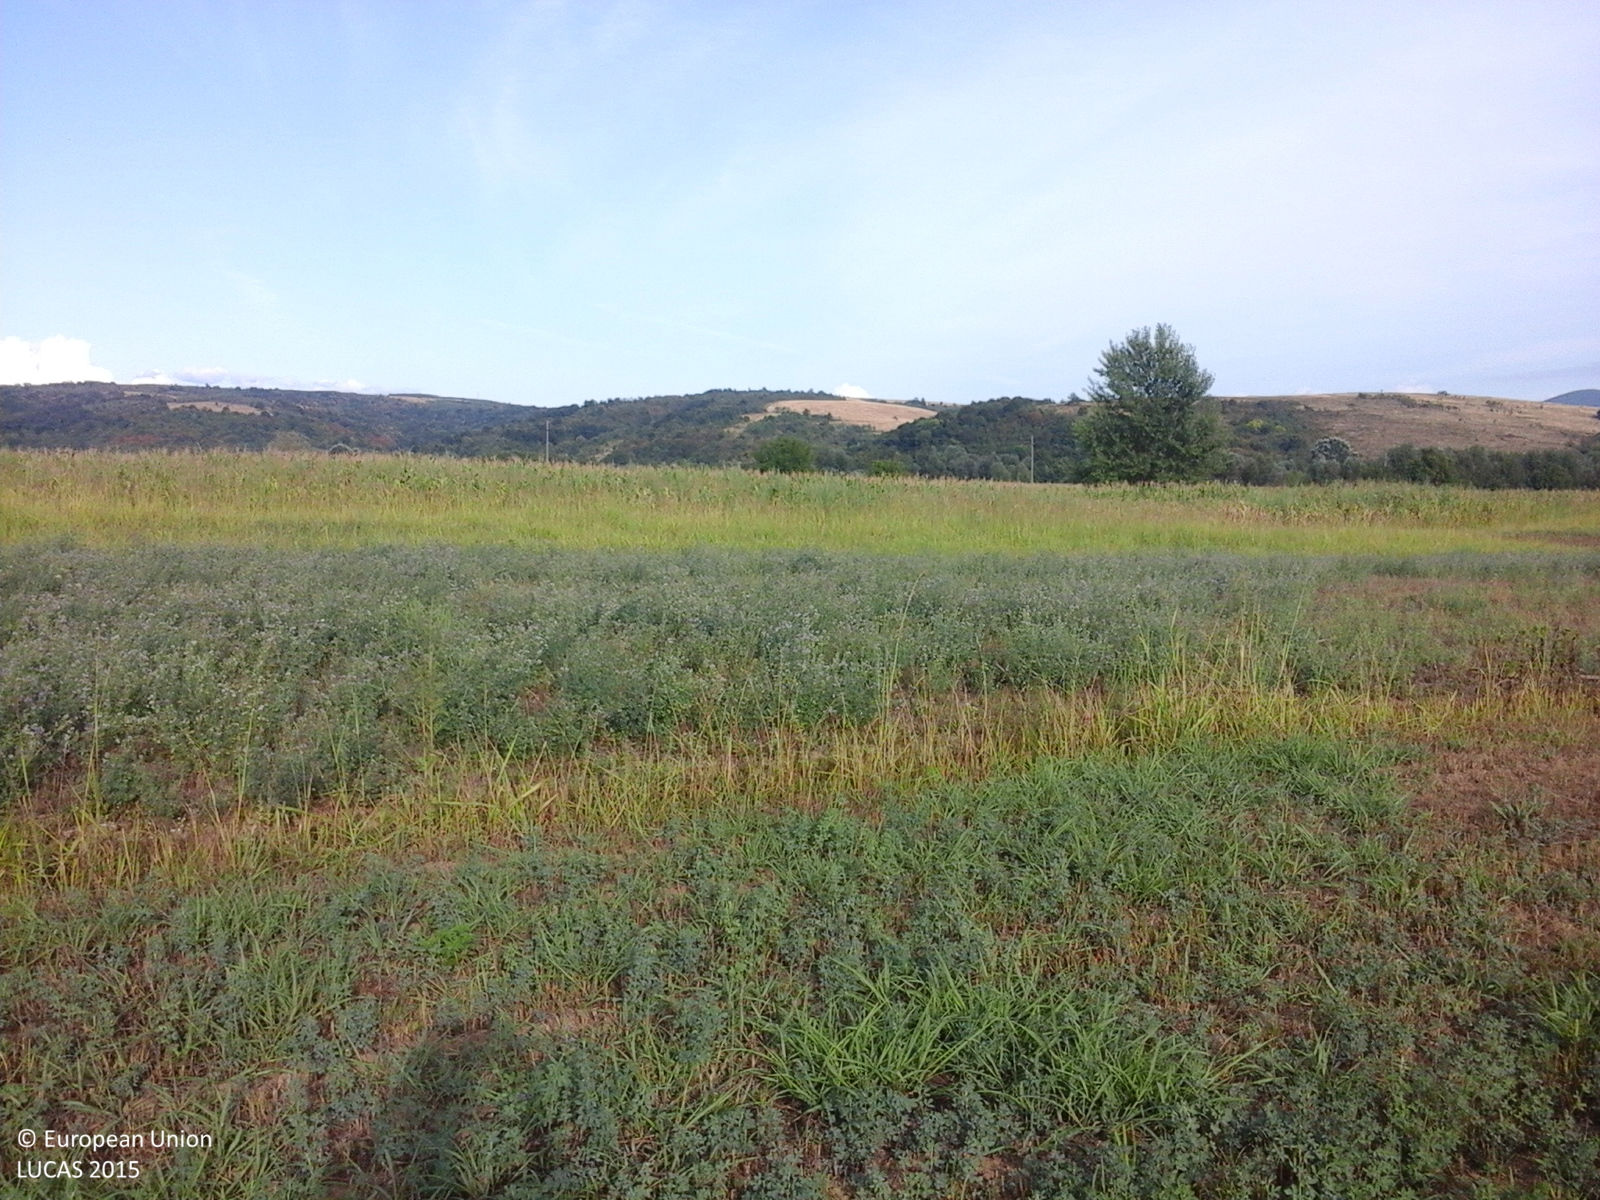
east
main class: Cropland
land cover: Lucerne
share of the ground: > 75 %
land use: Agriculture (excluding fallow land and kitchen gardens)
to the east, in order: Lucerne; Grass margins; Lucerne; Spontaneously vegetated surfaces; Maize; Lucerne; Spontaneously vegetated surfaces; Other leguminous and mixtures for fodder; Shruby margins; Lucerne; Maize; Shruby margins; Ditches and canals; Shruby margins; Tracks; Maize; Spontaneously vegetated surfaces; Electric lines; Spontaneously vegetated surfaces; Maize
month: August
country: RO
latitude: 45.1311
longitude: 21.6404
